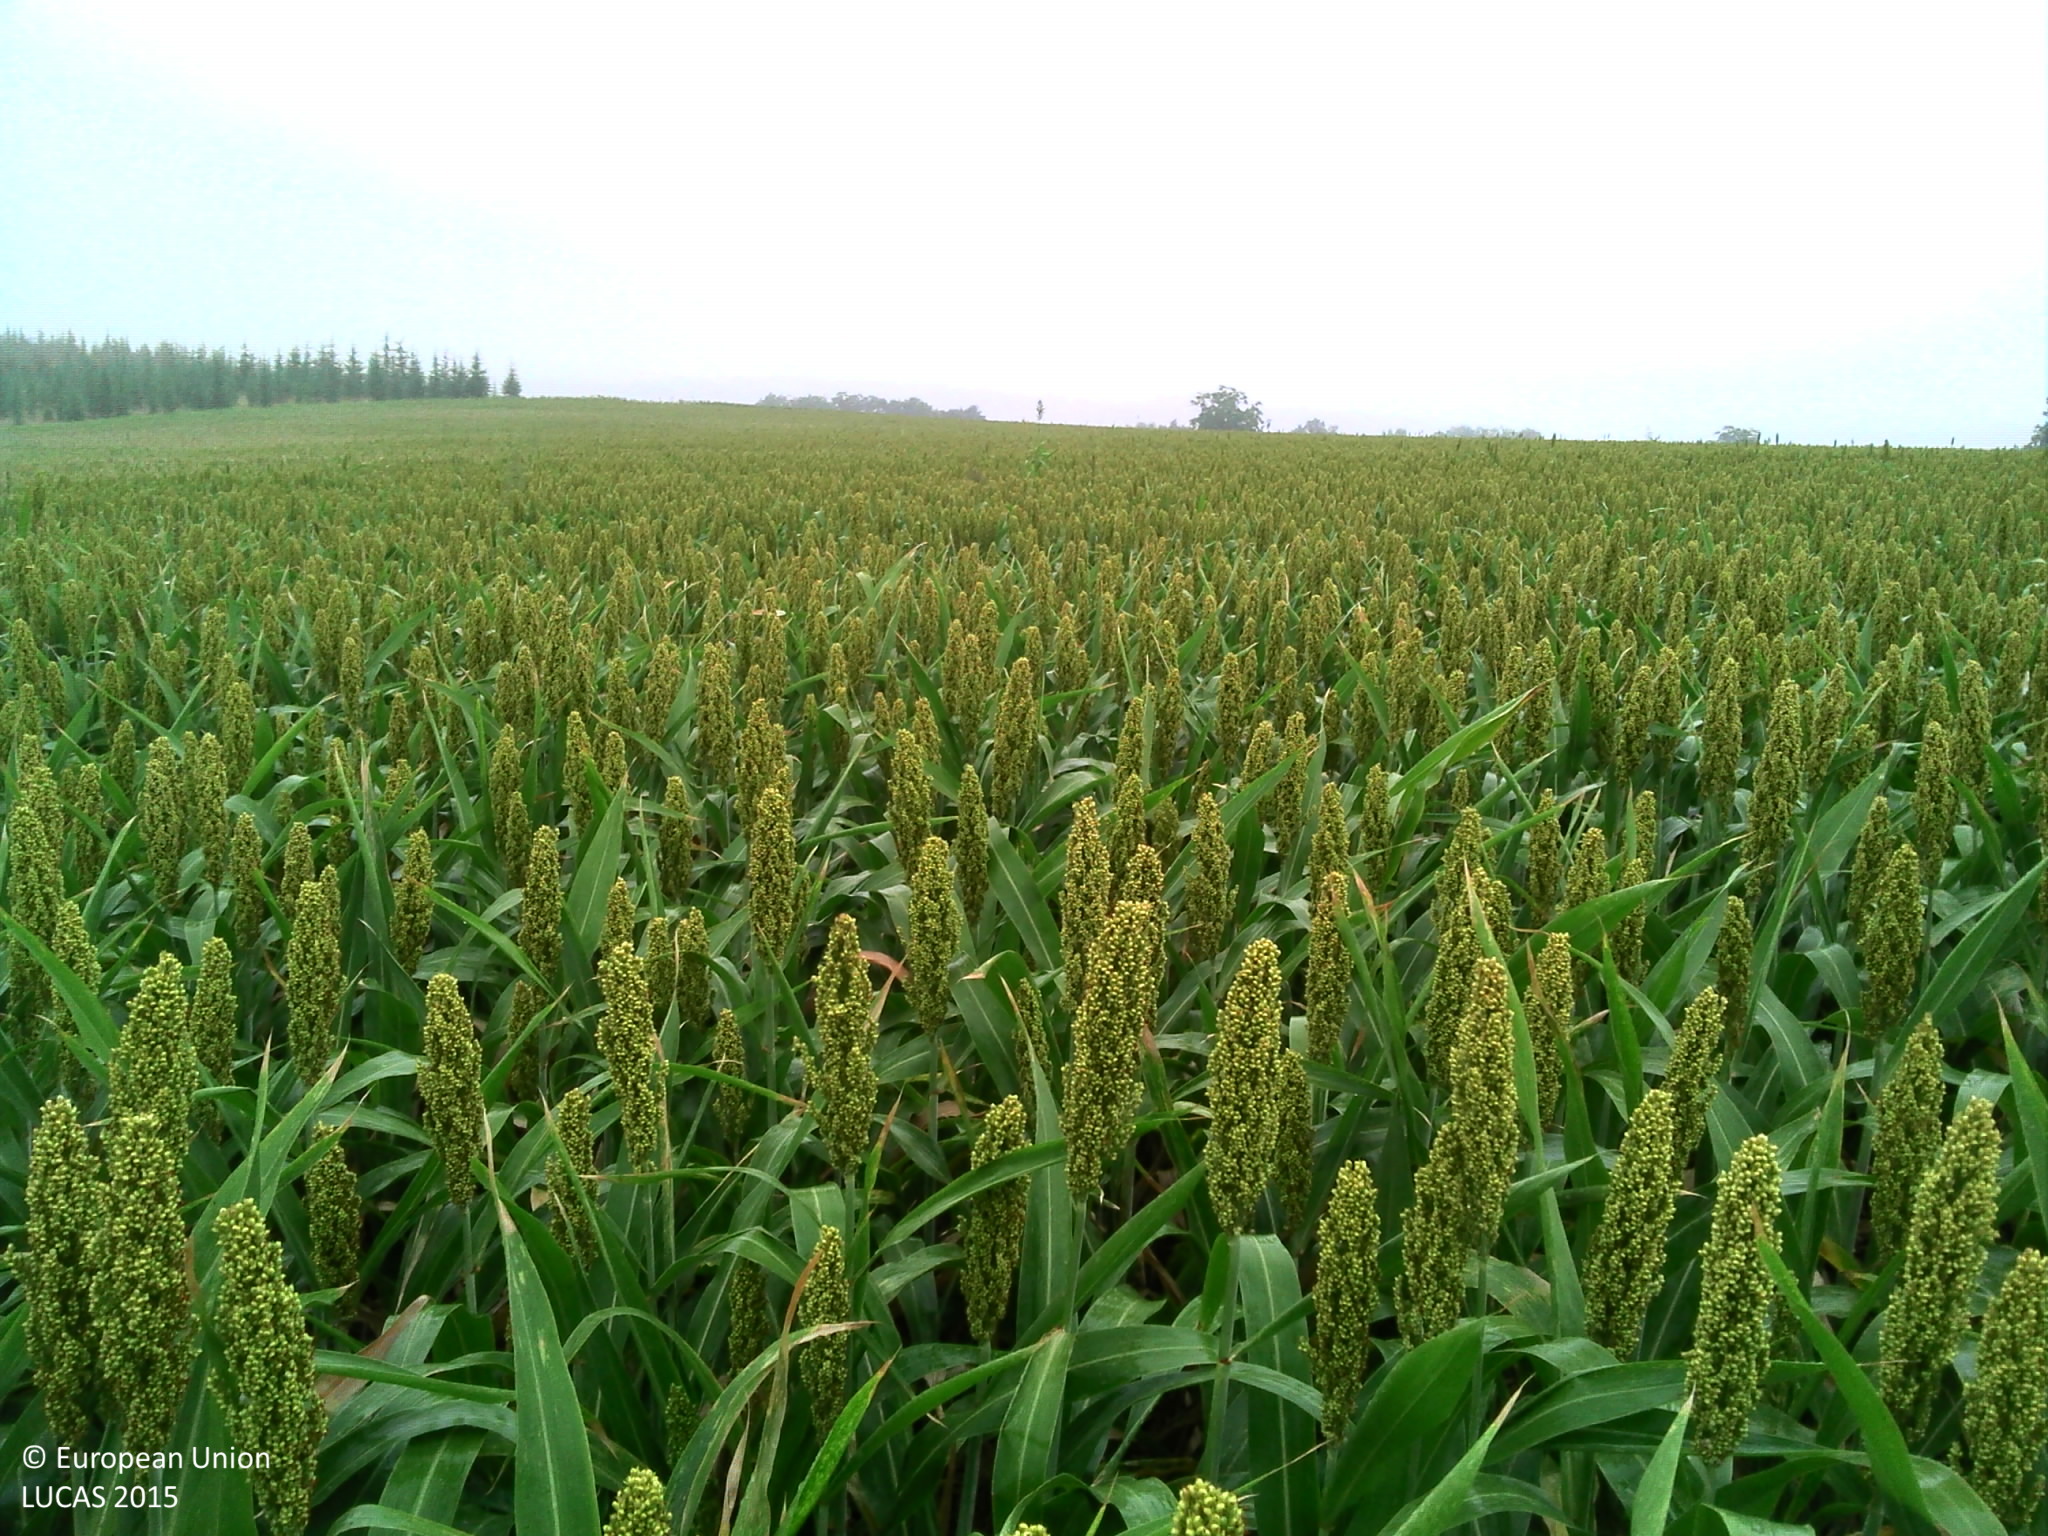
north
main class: Cropland
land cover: Other cereals
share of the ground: > 75 %
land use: Agriculture (excluding fallow land and kitchen gardens)
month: July
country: FR
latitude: 44.1816
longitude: 0.8521
